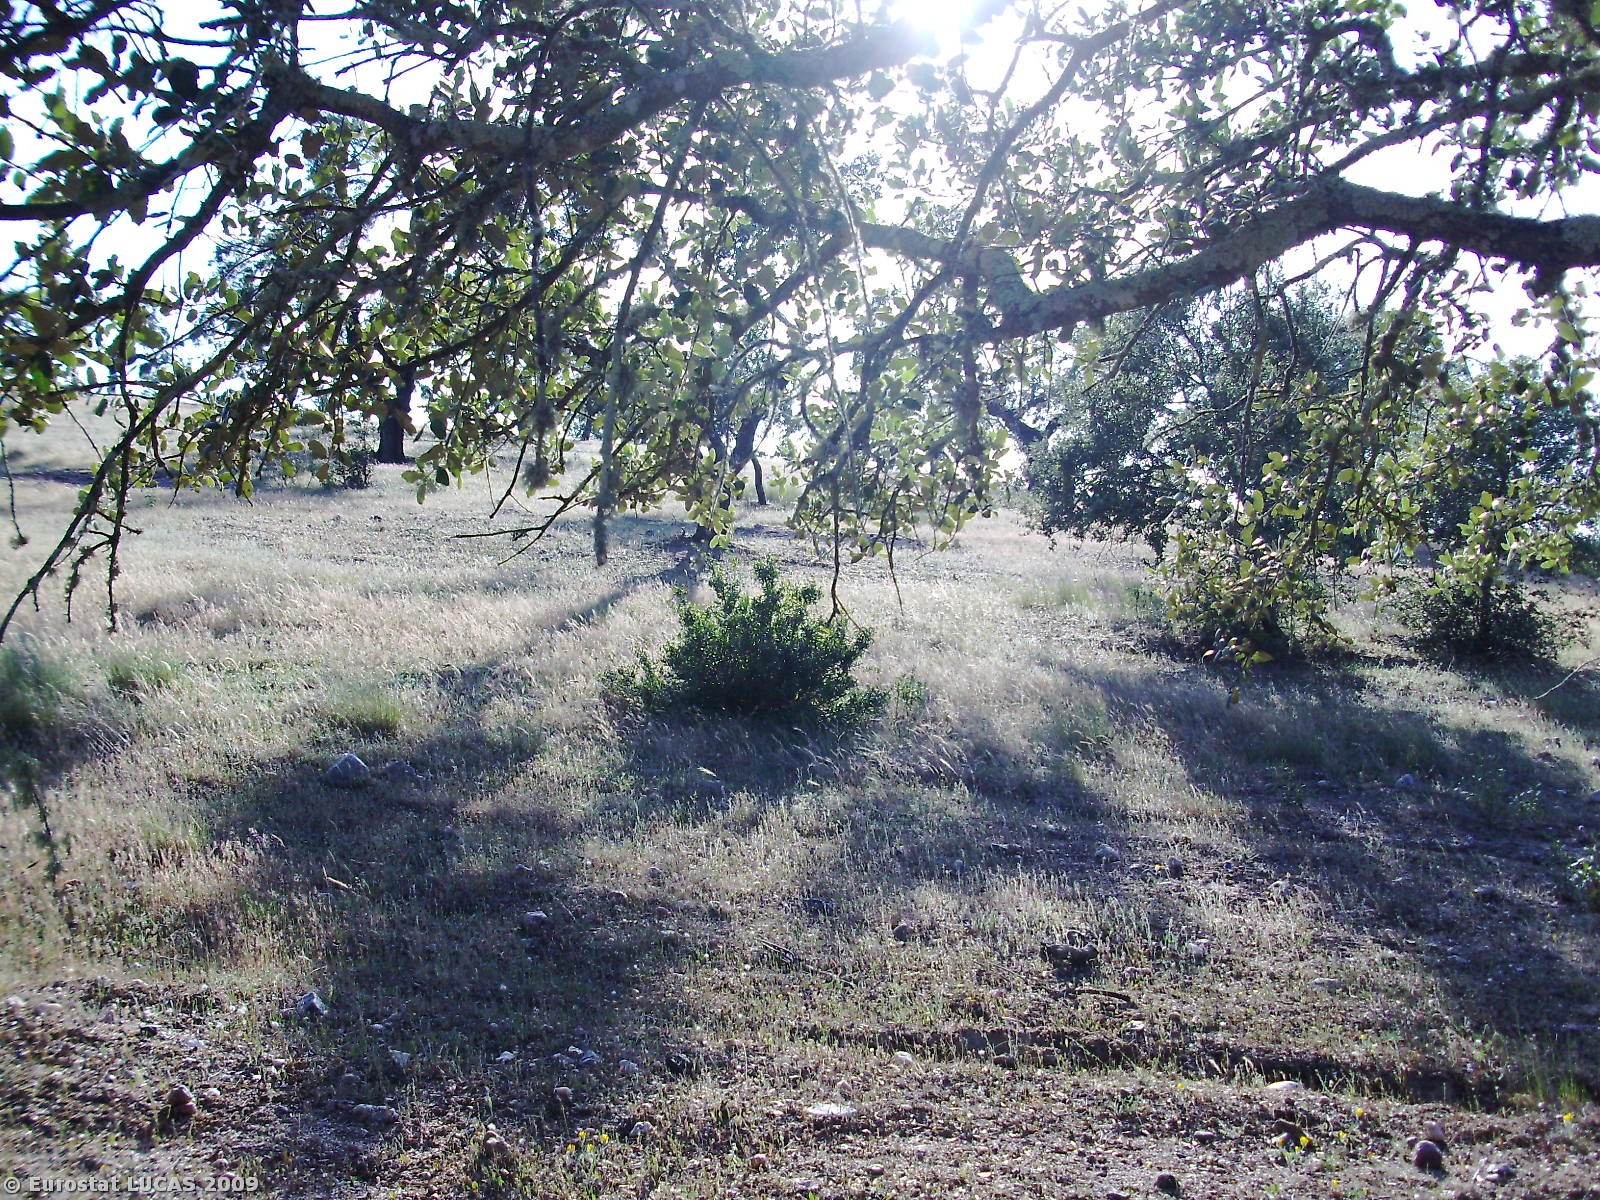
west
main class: Woodland
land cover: Broadleaved woodland
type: broadleaved evergreen forest
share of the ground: 25 - 50 %
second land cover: Spontaneously vegetated surfaces
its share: 25 - 50 %
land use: Forestry
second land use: Fallow land
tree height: > 5 m
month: May
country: PT
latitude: 39.0353
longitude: -7.7781
